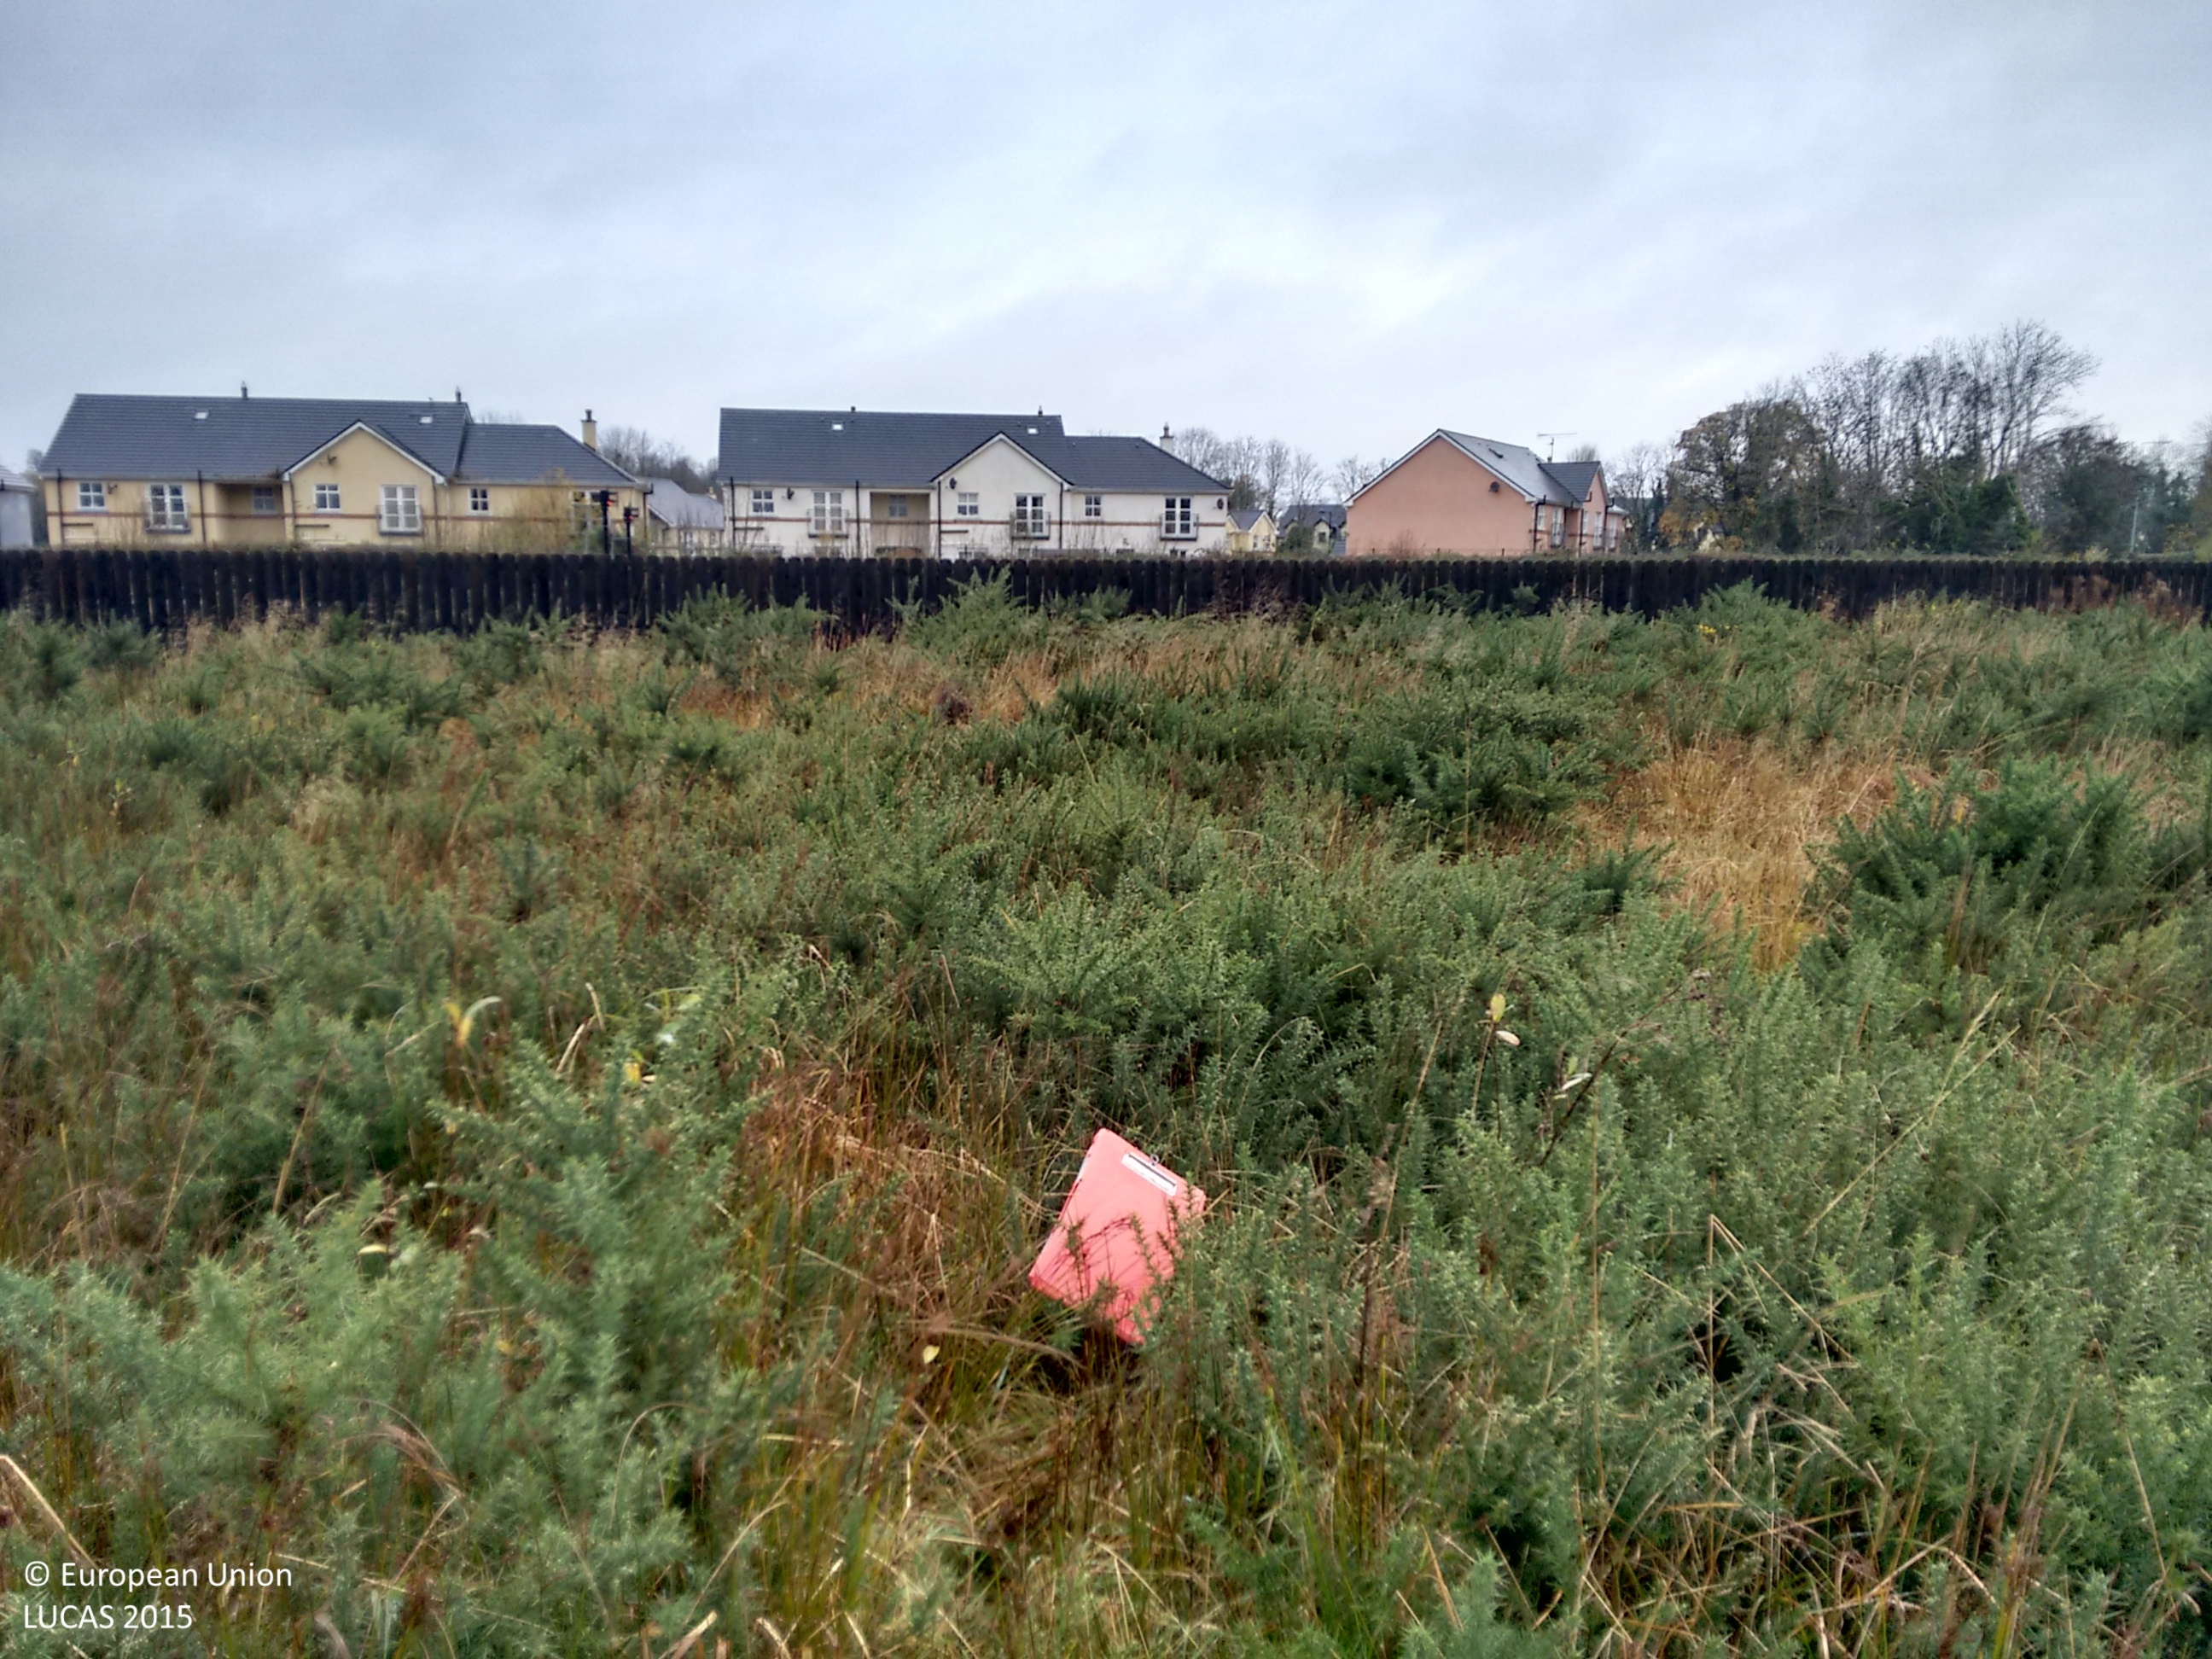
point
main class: Grassland
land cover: Spontaneously vegetated surfaces
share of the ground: > 75 %
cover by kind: herbaceous plants 95 %, shrubs 5 %
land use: Abandoned areas
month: November
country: IE
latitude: 53.8579
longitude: -7.9144
